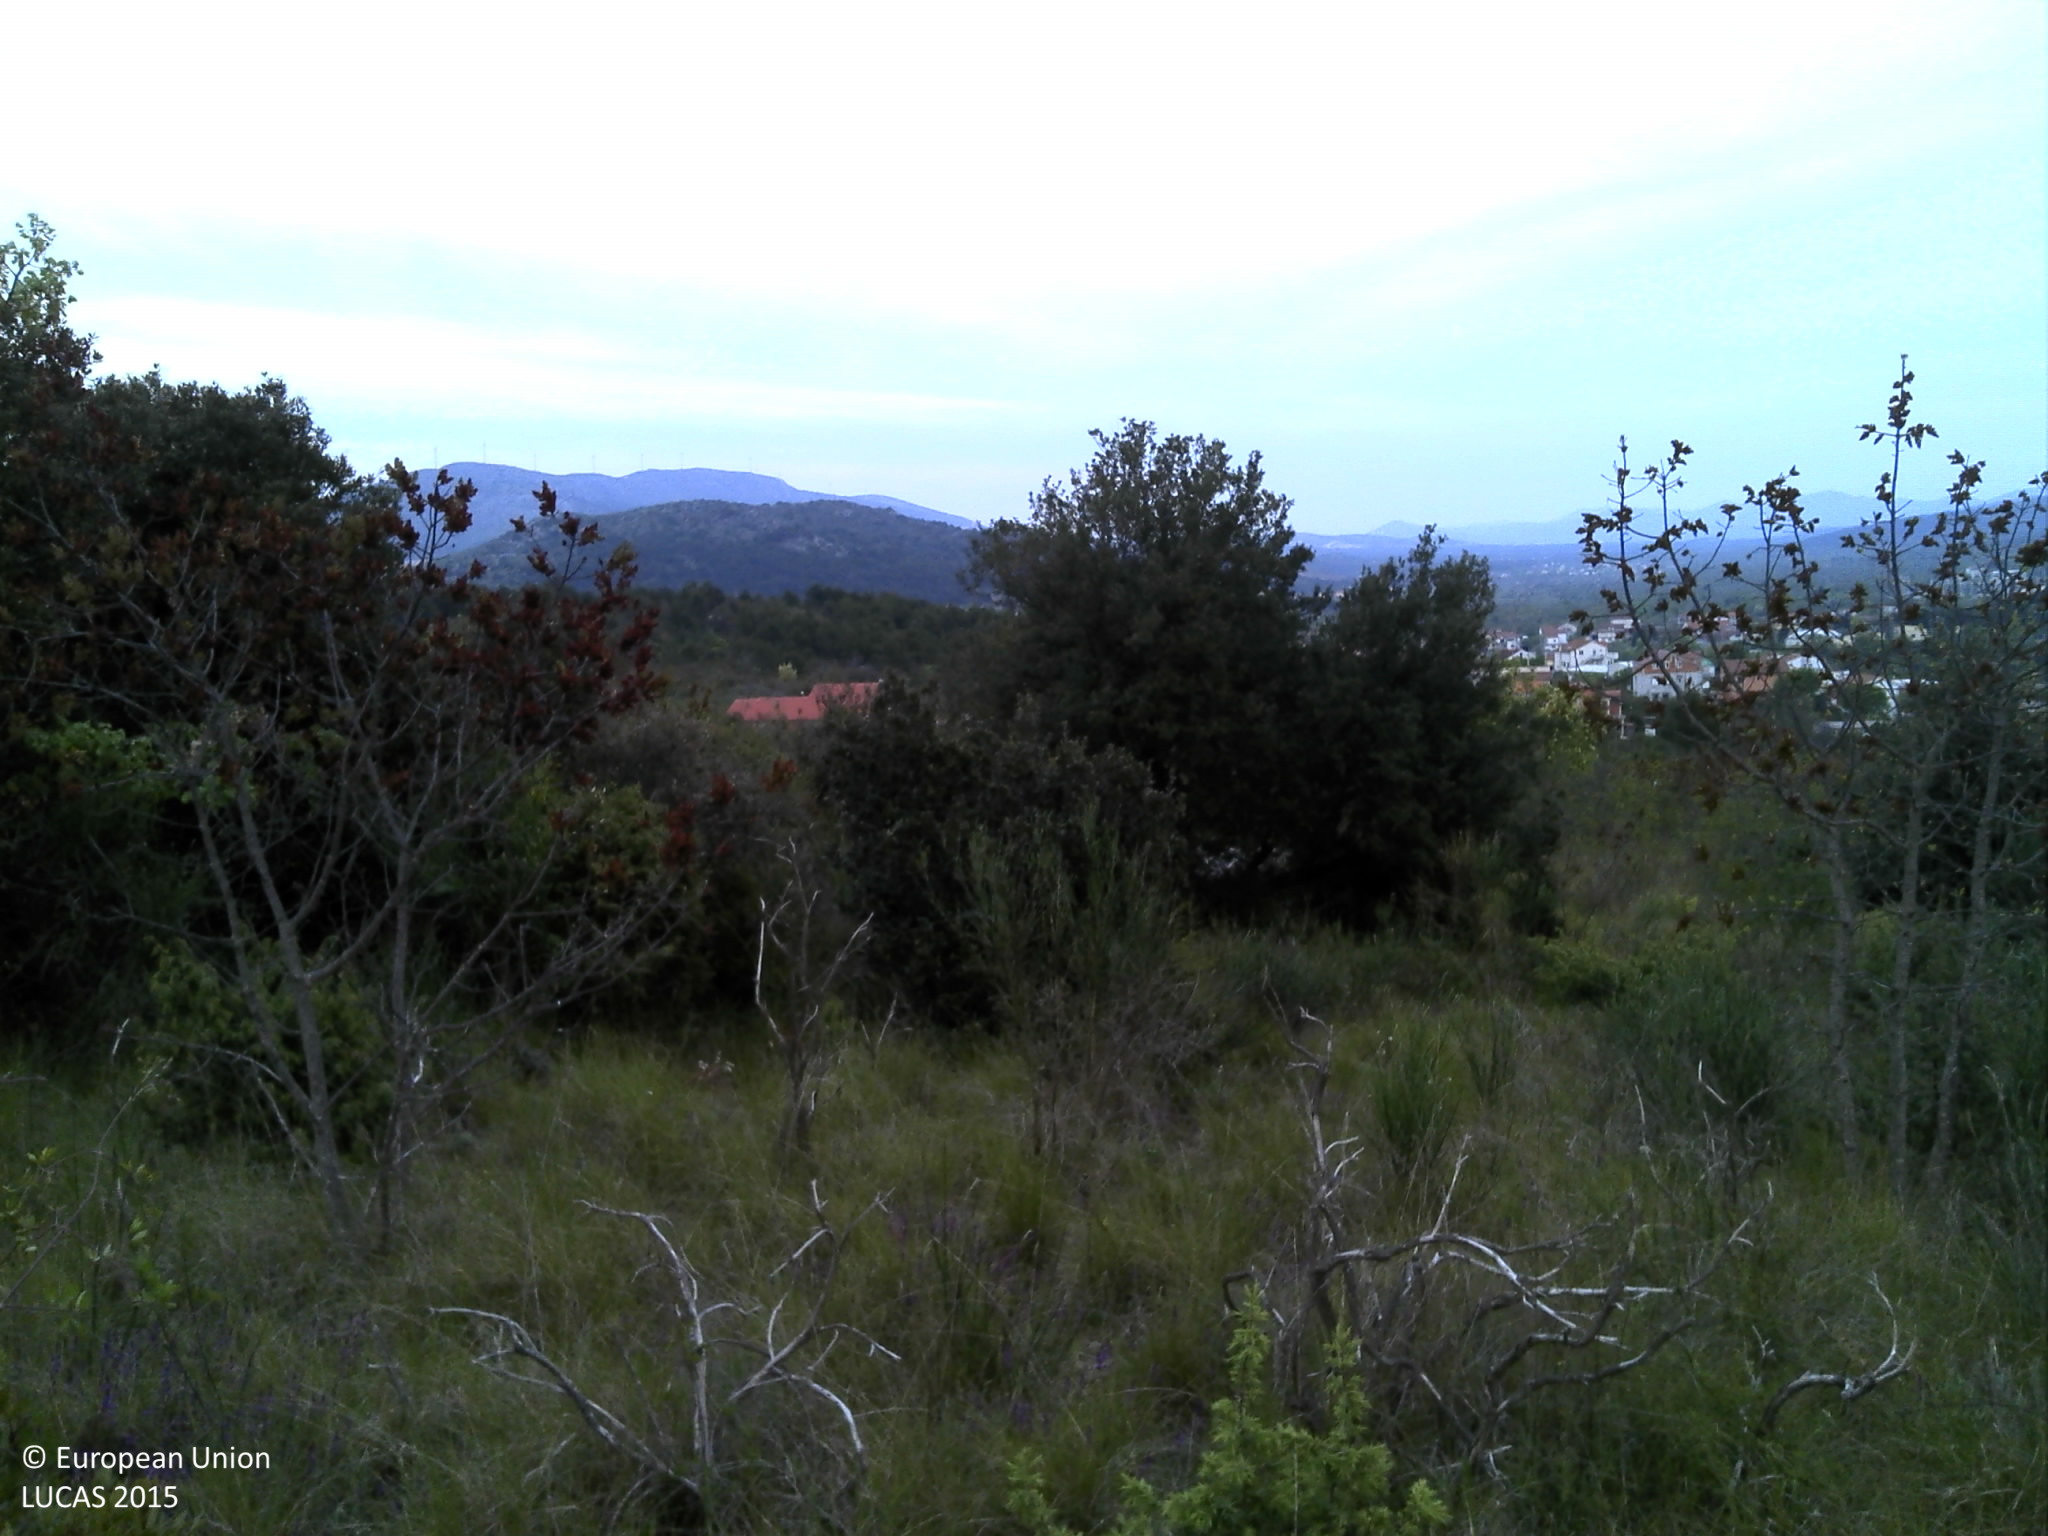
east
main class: Shrubland
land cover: Shrubland with sparse tree cover
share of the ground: 50 - 75 %
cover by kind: shrubs 45 %, herbaceous plants 30 %, unconsolidated bare surface 20 %, coniferous forest trees 5 %
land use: Semi-natural and natural areas not in use
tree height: < 5 m
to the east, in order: Shrubland with sparse tree cover; Dry stone walls; Shrubland with sparse tree cover; Dry stone walls; Shrubland with sparse tree cover; Dry stone walls; Shrubland with sparse tree cover; Artificial constructions in urban areas; Pine dominated coniferous woodland; Dry stone walls; Shrubland with sparse tree cover; Tracks; Shrubland with sparse tree cover
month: April
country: HR
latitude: 43.7672
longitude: 15.8918
